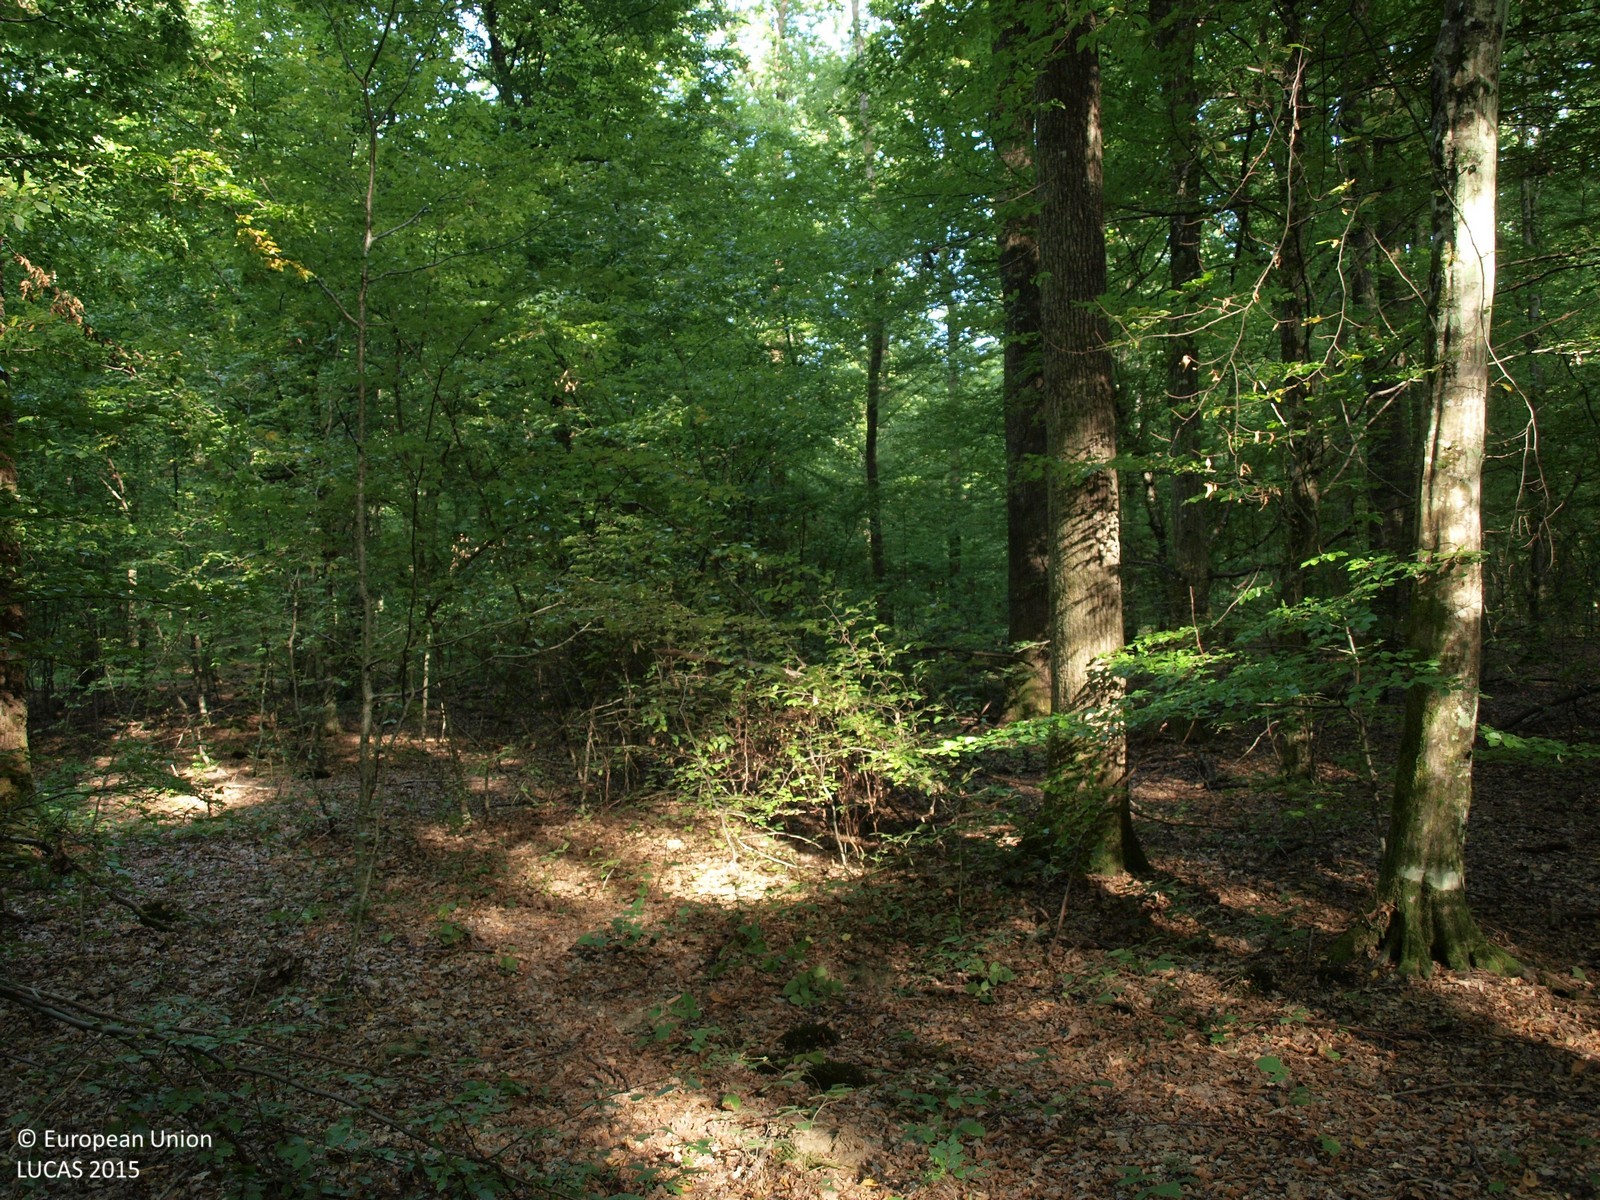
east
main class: Woodland
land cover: Broadleaved woodland
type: mesophytic deciduous forest
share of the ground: > 75 %
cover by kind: broadleaved forest trees 100 %
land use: Forestry
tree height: > 5 m
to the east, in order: Broadleaved woodland
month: September
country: HR
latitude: 45.6177
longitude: 16.0892
